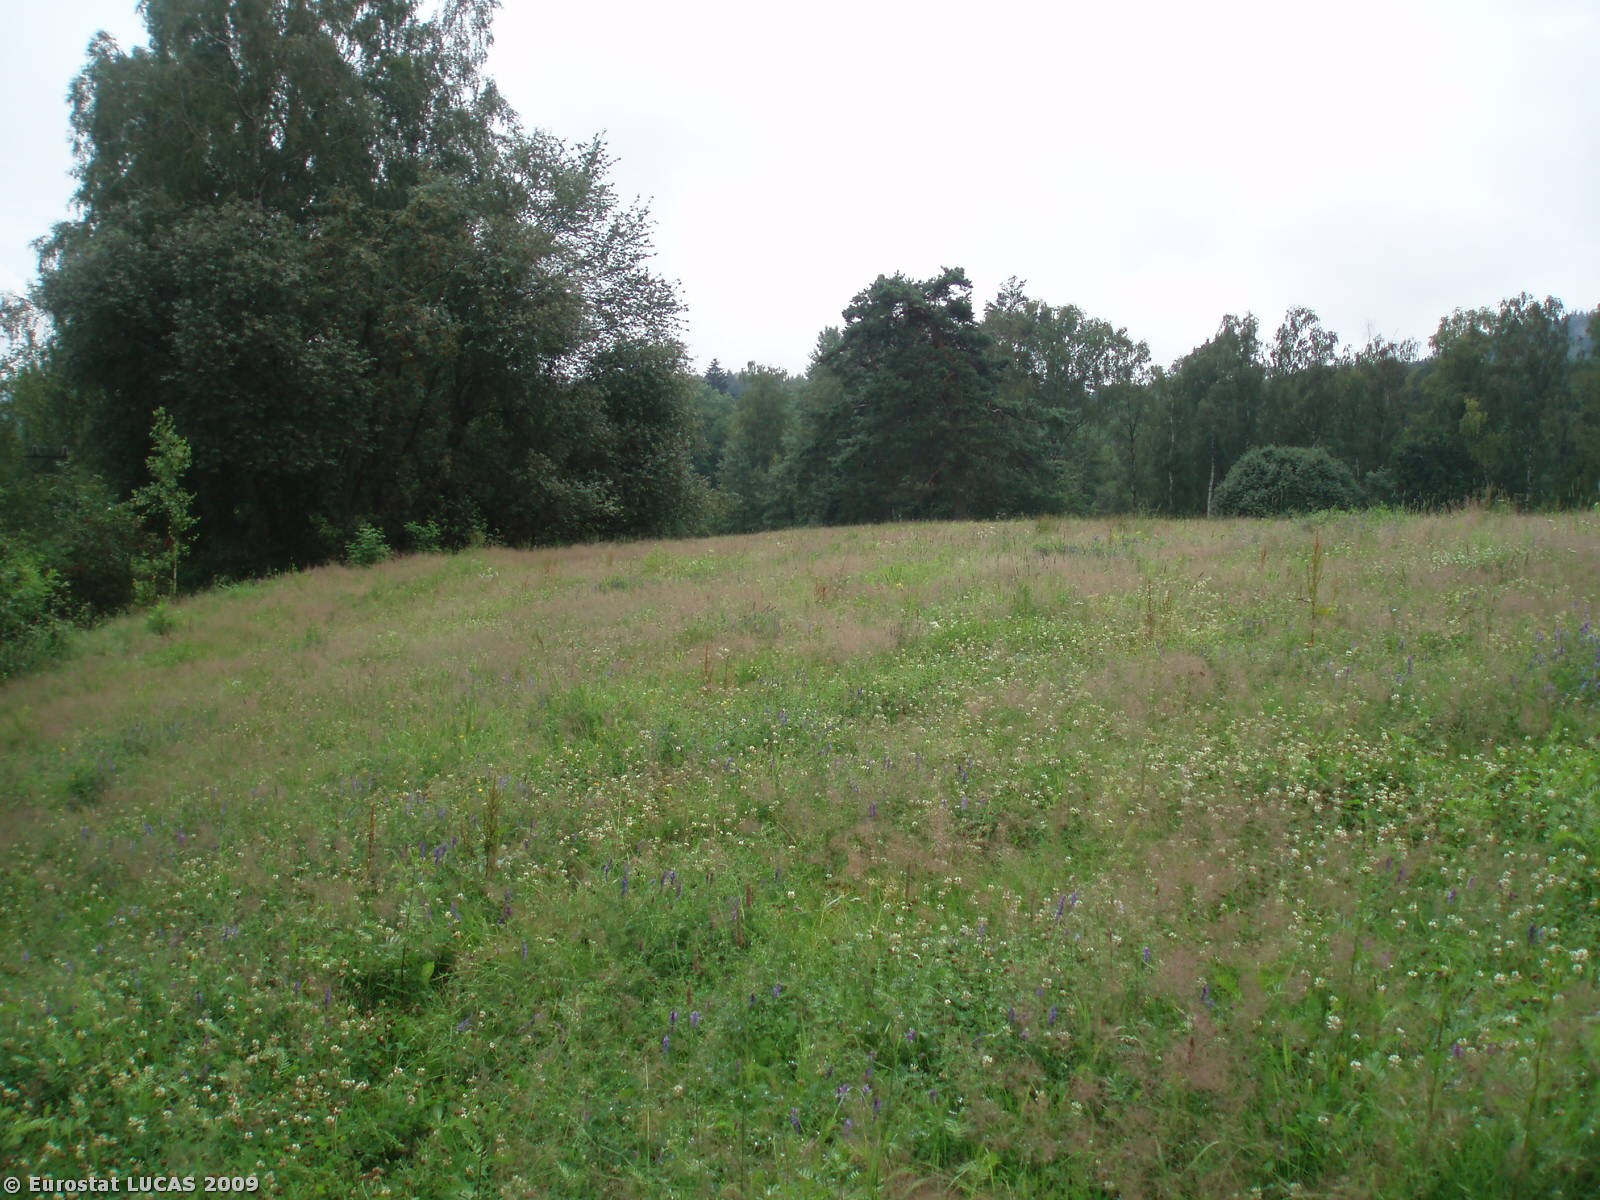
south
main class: Grassland
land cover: Grassland without tree/shrub cover
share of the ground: > 75 %
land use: Agriculture (excluding fallow land and kitchen gardens)
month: July
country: CZ
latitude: 50.7911
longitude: 14.6693
